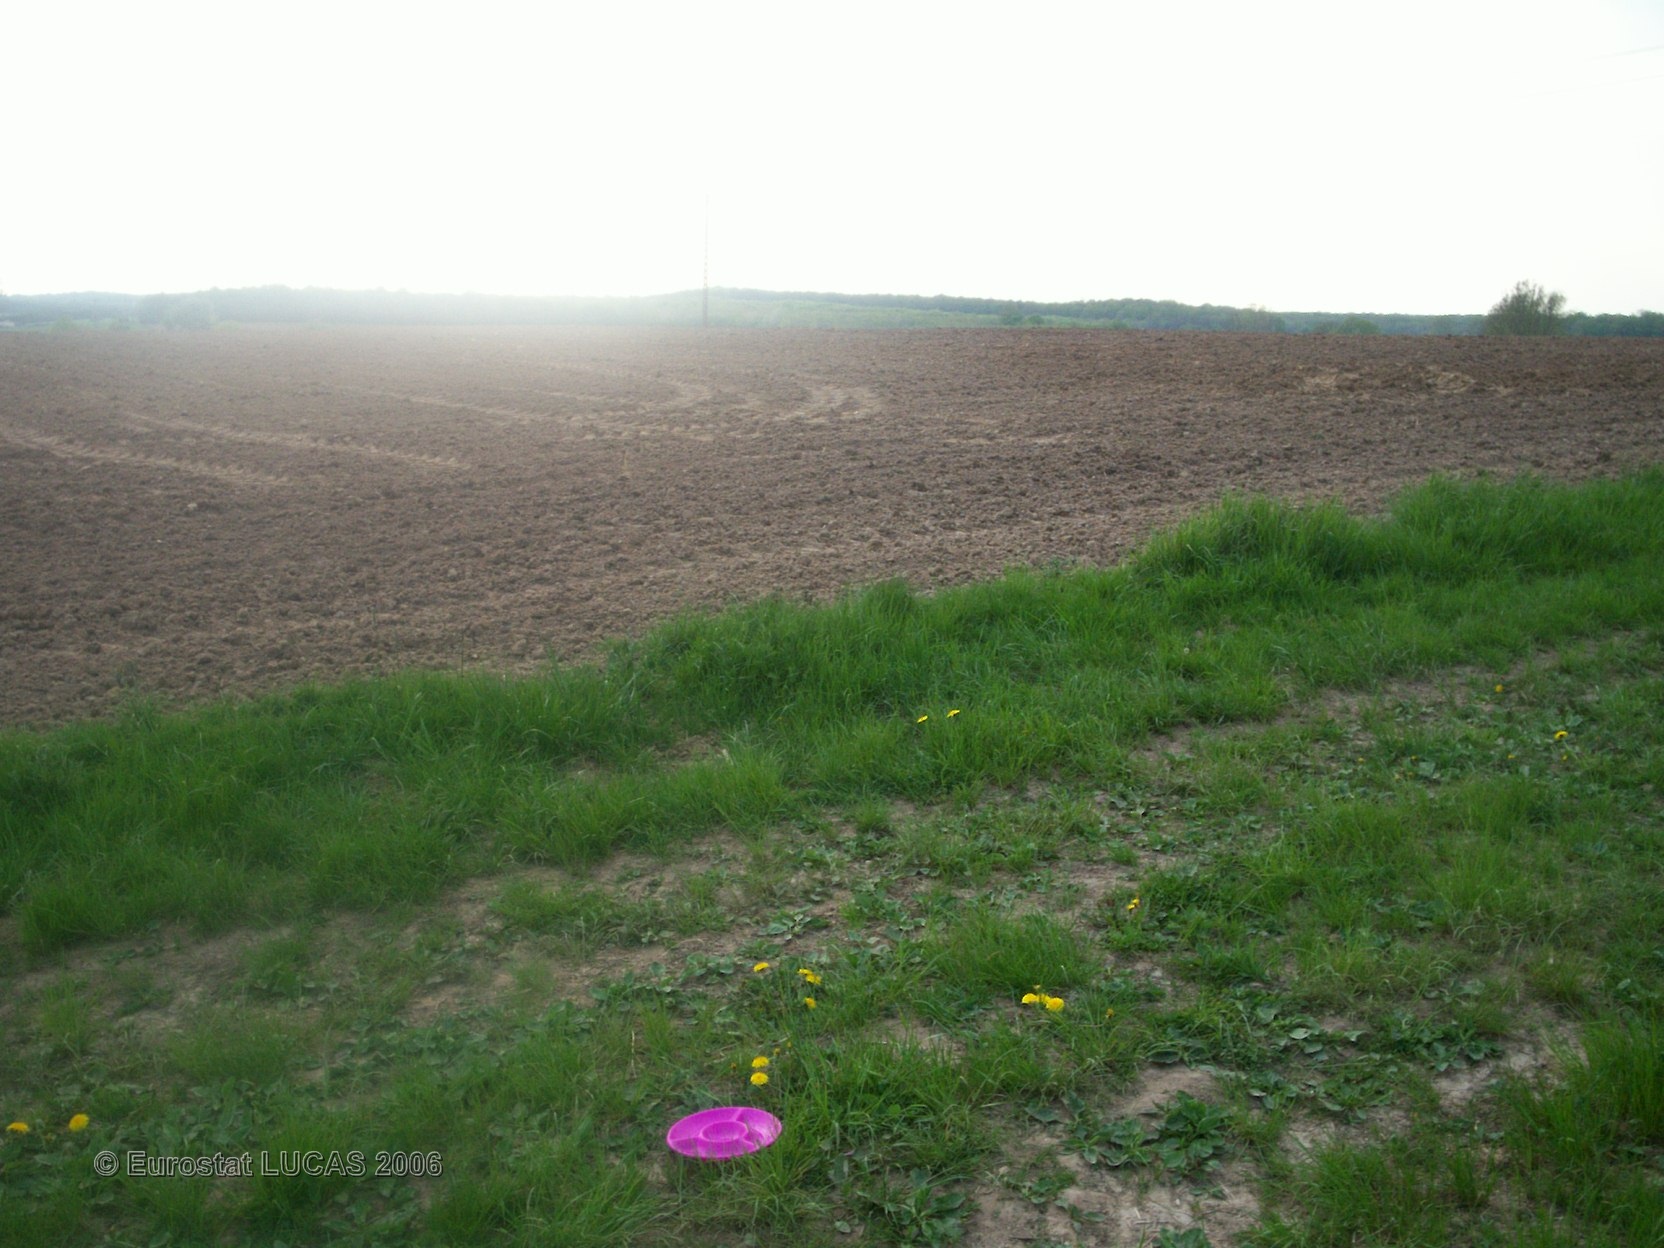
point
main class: Artificial land
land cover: Non built-up linear features
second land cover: Grassland without tree/shrub cover
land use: Road transport
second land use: Agriculture (excluding fallow land and kitchen gardens)
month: May
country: FR
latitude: 48.8127
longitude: 6.9910
